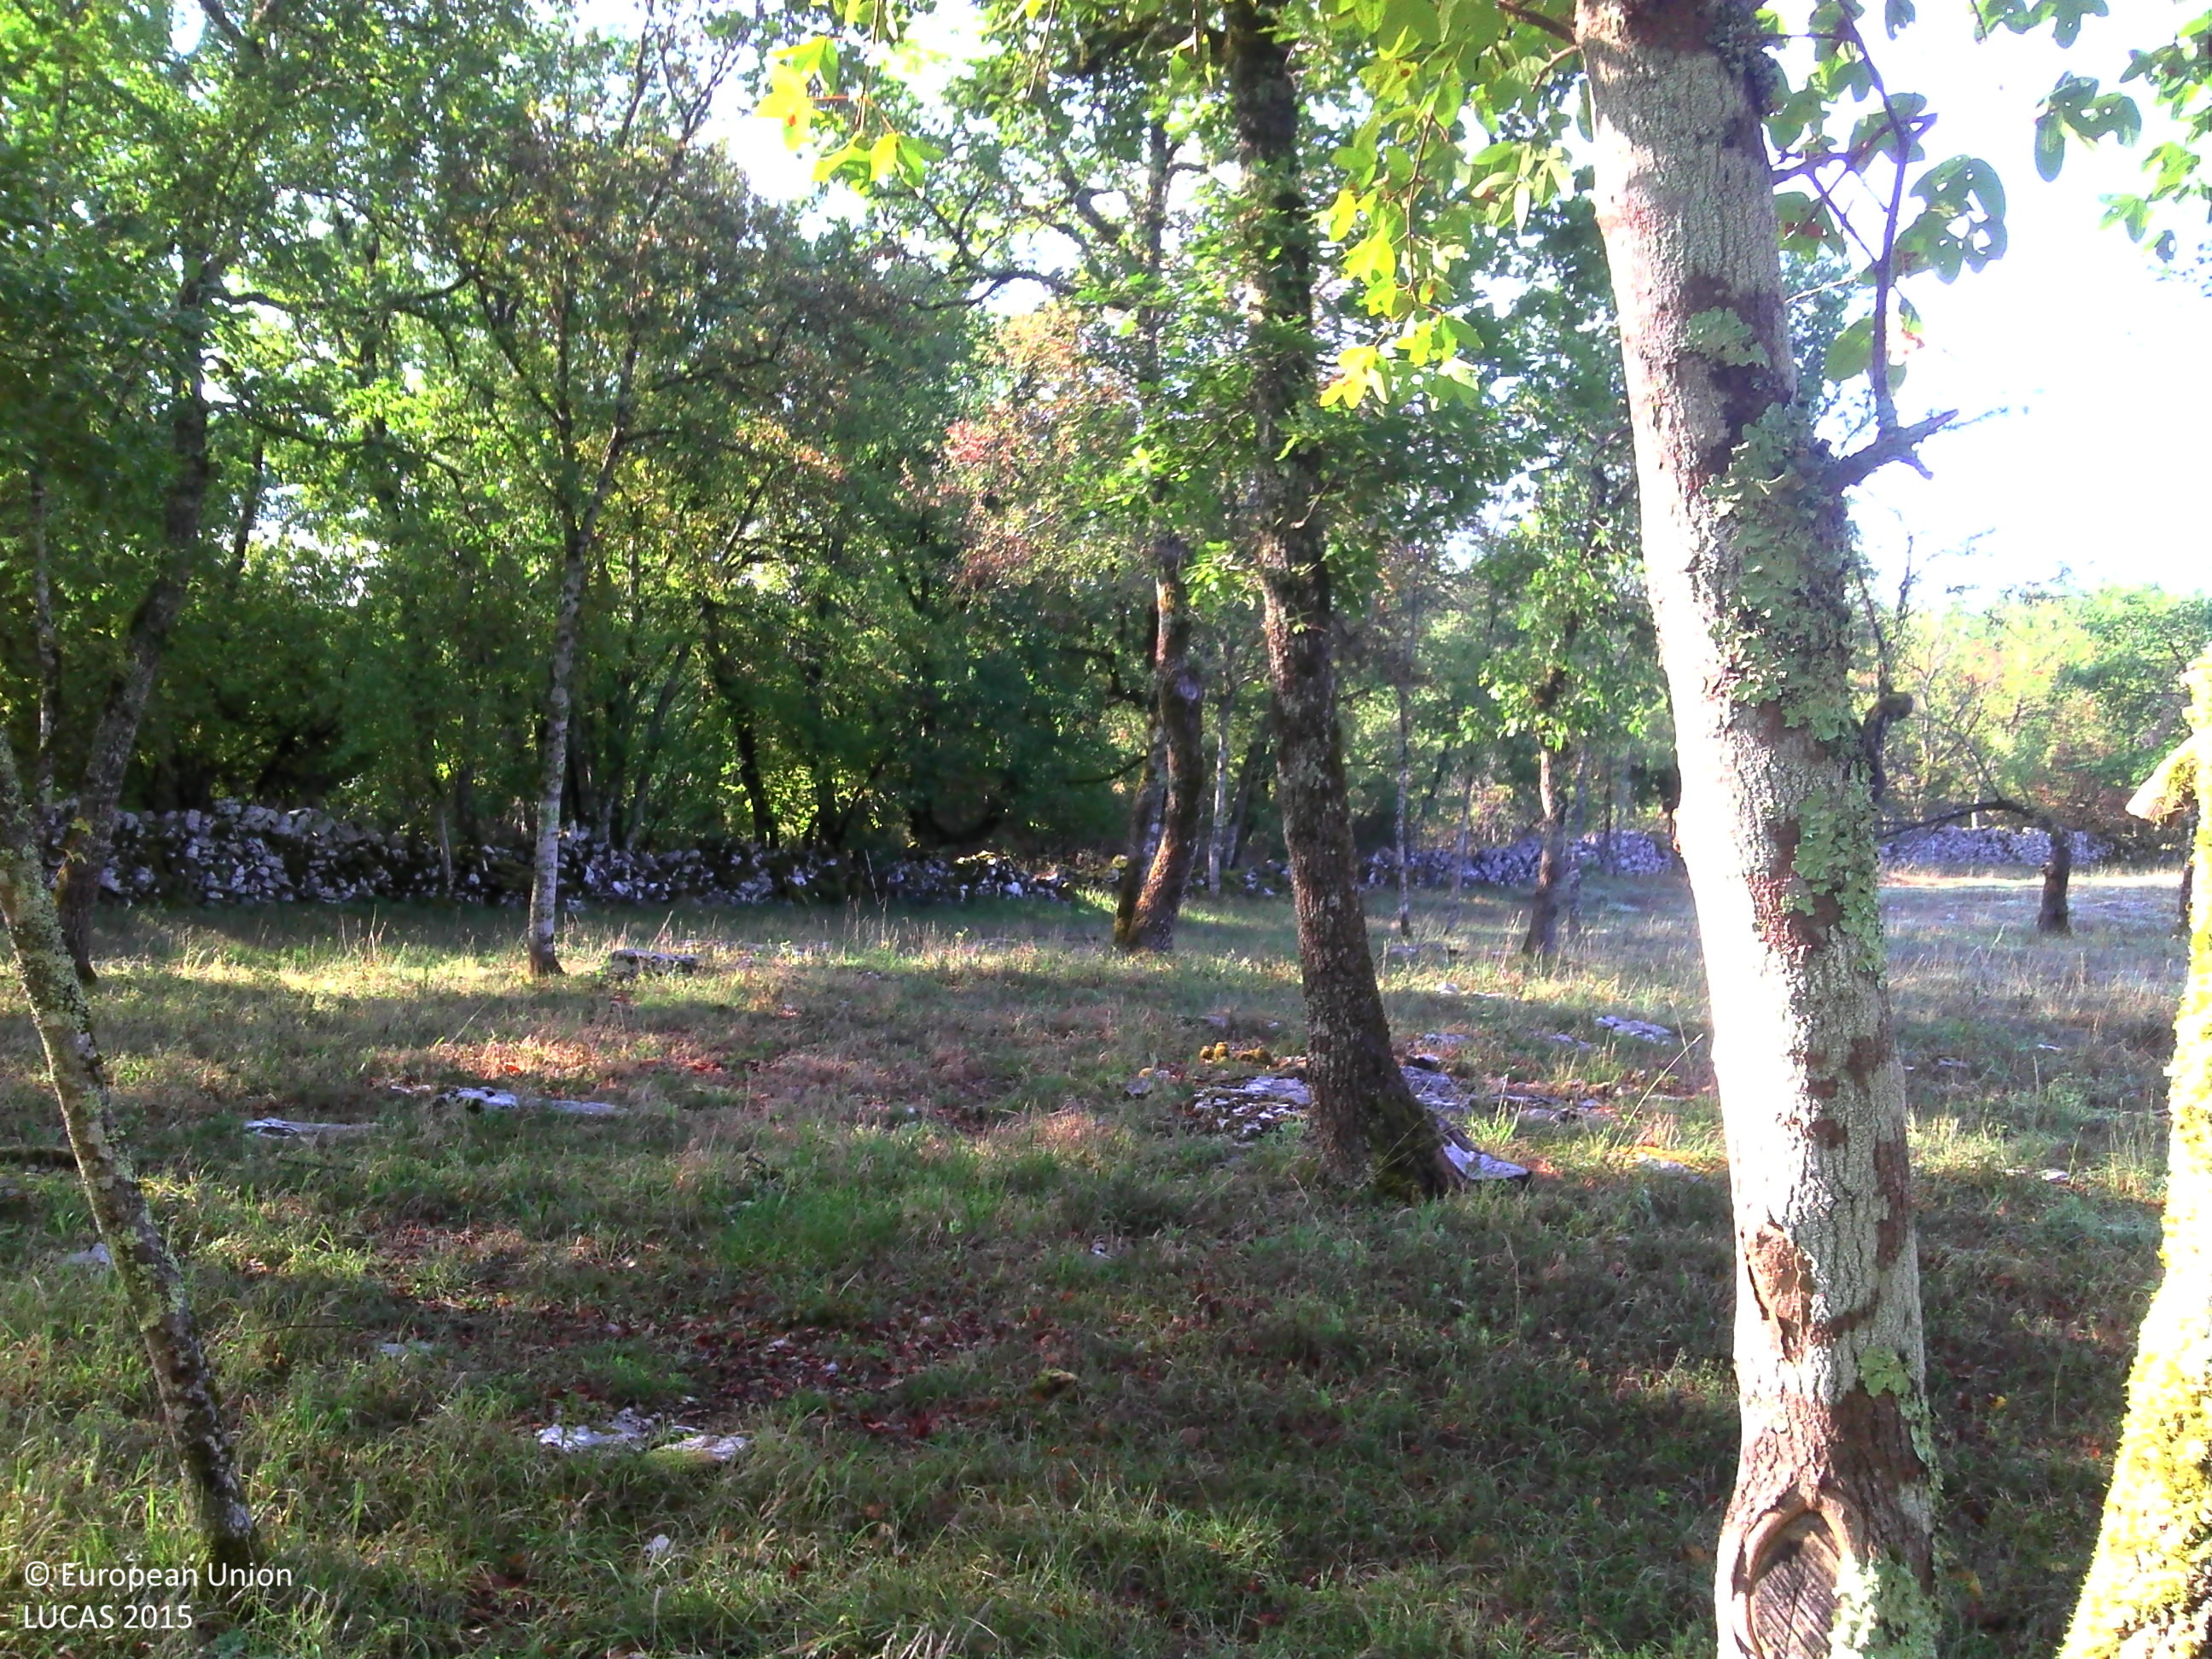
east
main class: Woodland
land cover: Broadleaved woodland
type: mesophytic deciduous forest
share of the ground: 50 - 75 %
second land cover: Grassland without tree/shrub cover
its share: 25 - 50 %
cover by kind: broadleaved forest trees 70 %, herbaceous plants 30 %
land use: Agriculture (excluding fallow land and kitchen gardens)
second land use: Forestry
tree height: > 5 m
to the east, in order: Broadleaved woodland; Grassland without tree/shrub cover; Fences; Dry stone walls; Fences; Broadleaved woodland; Fences; Abandoned hedges; Dry stone walls; Broadleaved woodland
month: September
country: FR
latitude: 44.6827
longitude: 1.6333
